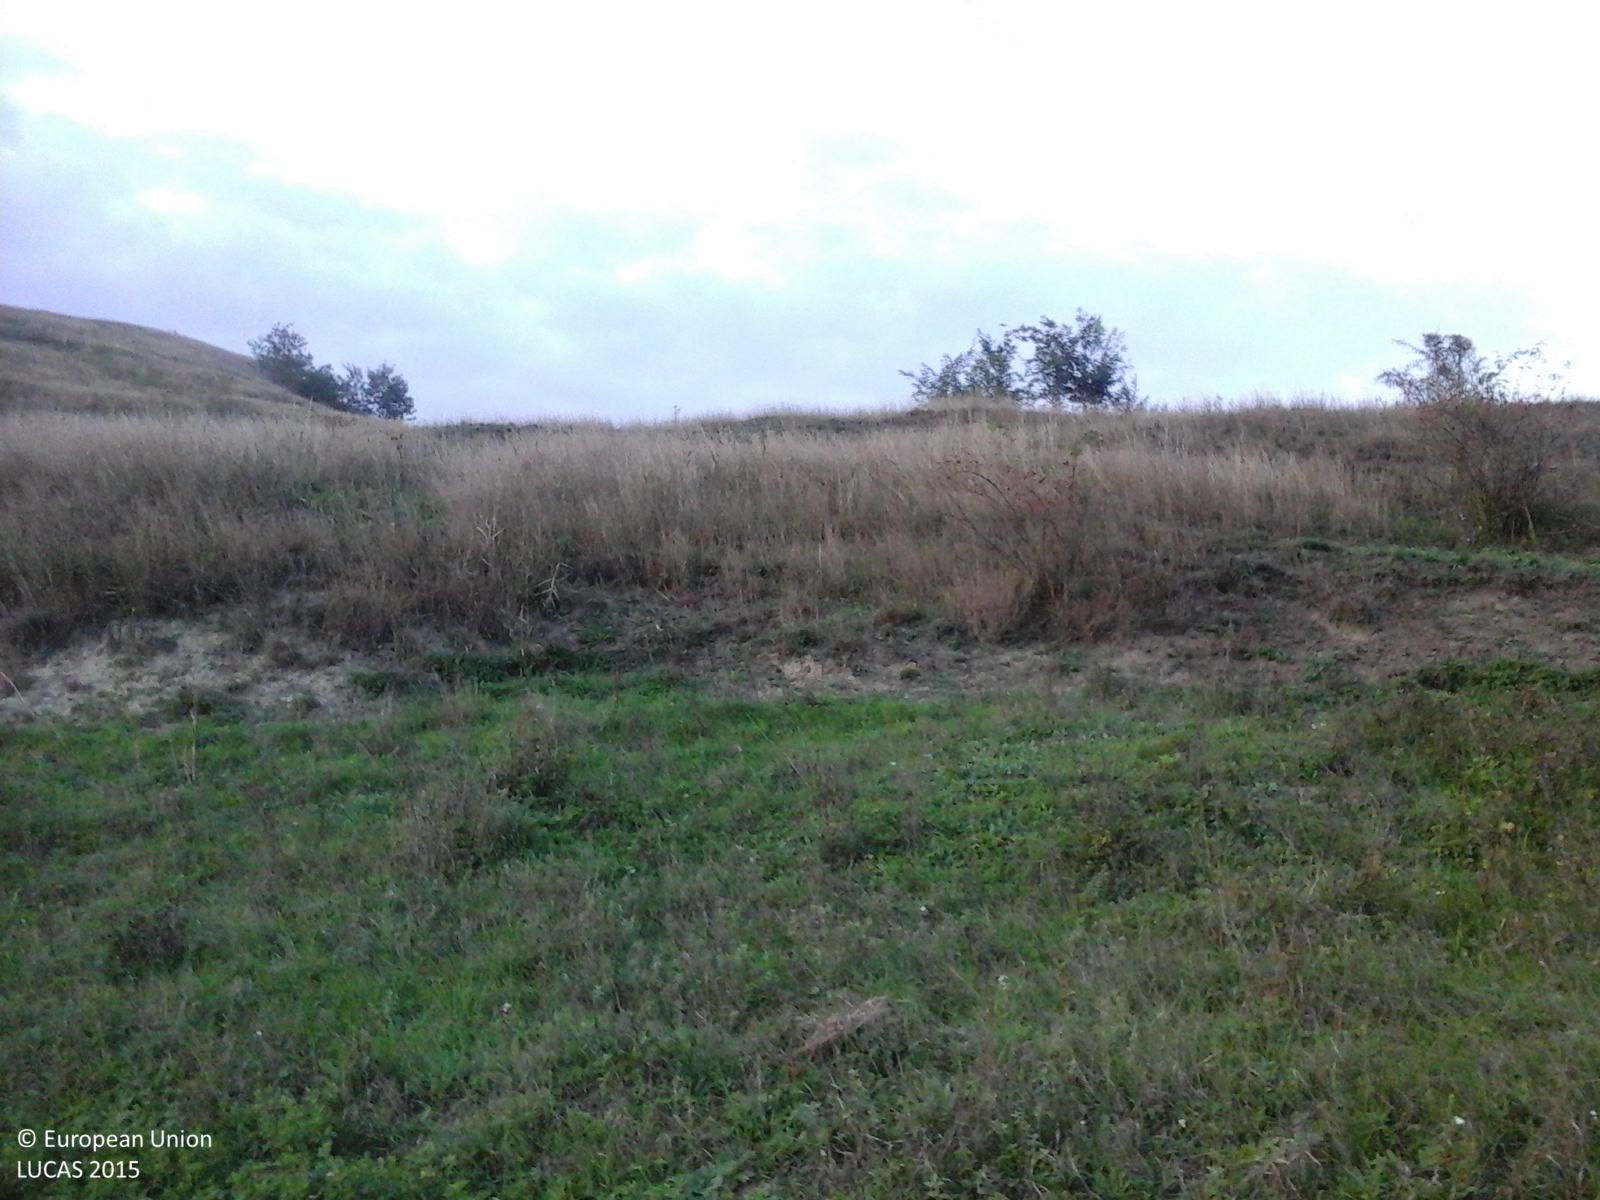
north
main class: Cropland
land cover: Lucerne
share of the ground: > 75 %
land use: Agriculture (excluding fallow land and kitchen gardens)
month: October
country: RO
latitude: 46.5911
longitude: 24.2970
